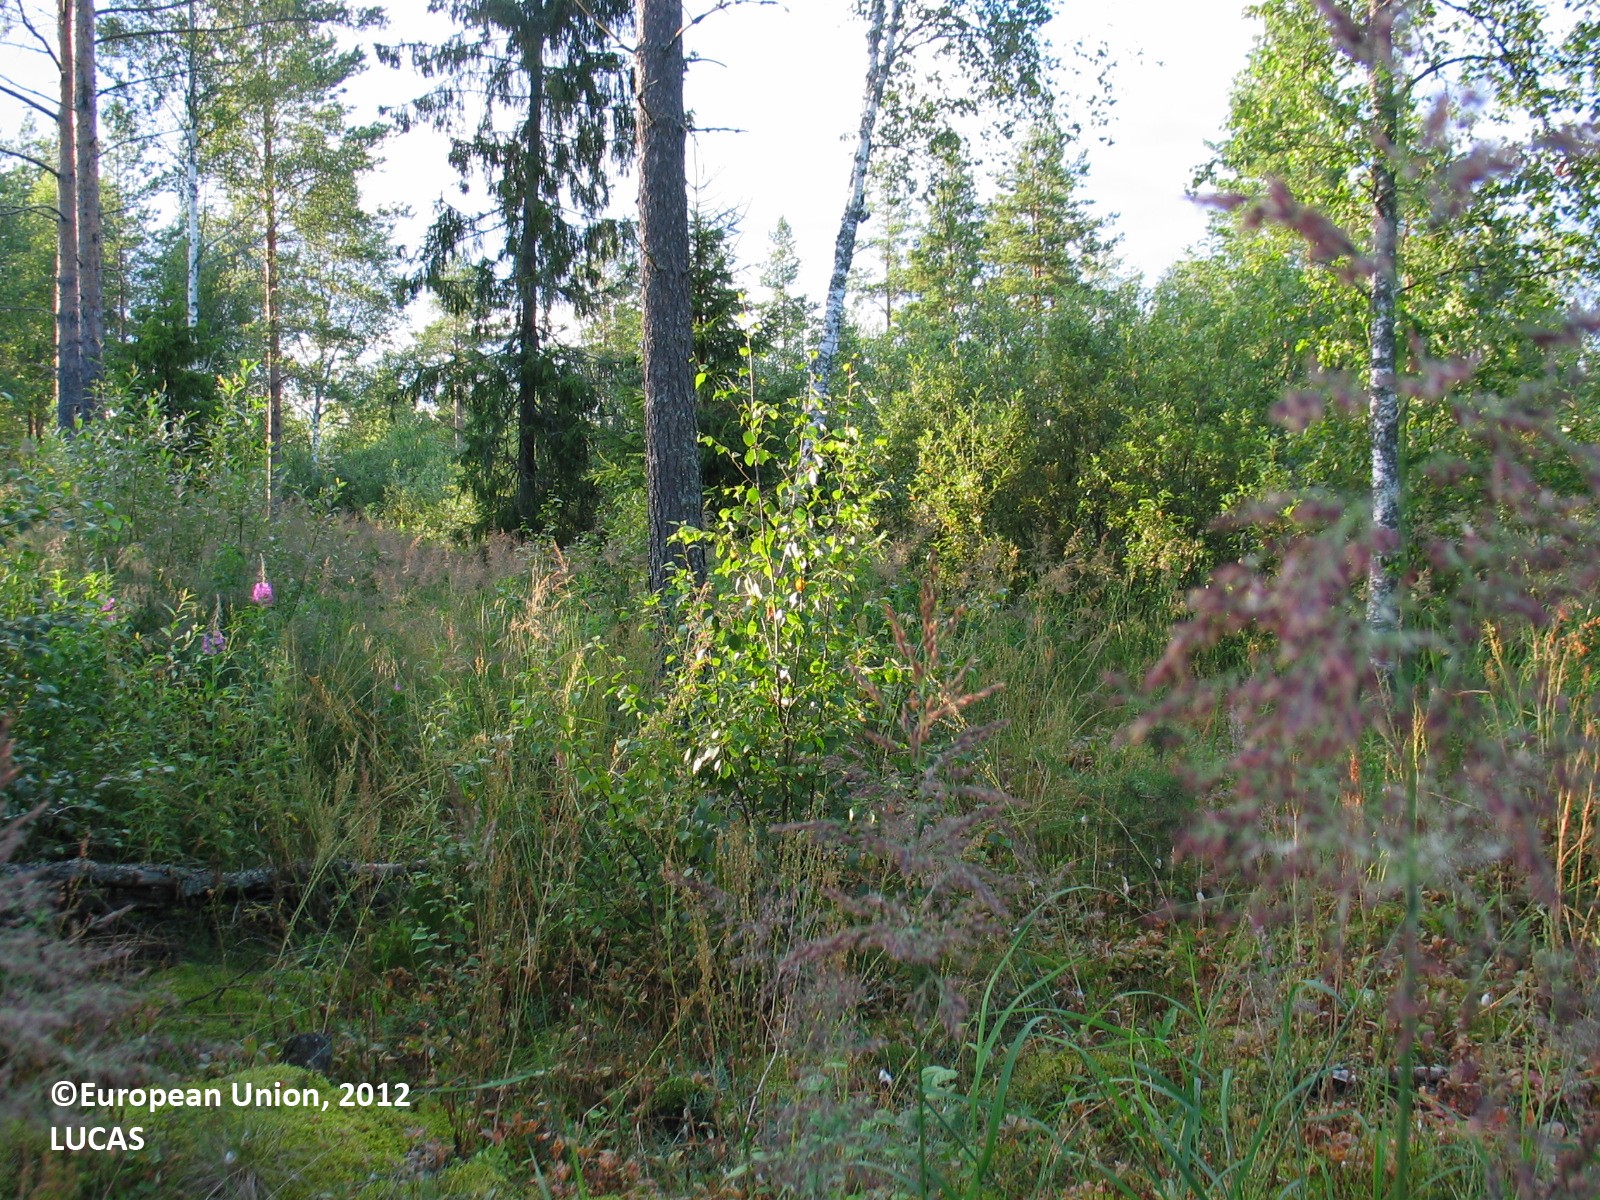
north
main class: Woodland
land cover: Other mixed woodland
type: boreal forest
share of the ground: 25 - 50 %
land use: Forestry
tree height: > 5 m
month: July
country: FI
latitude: 64.7034
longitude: 26.4067
